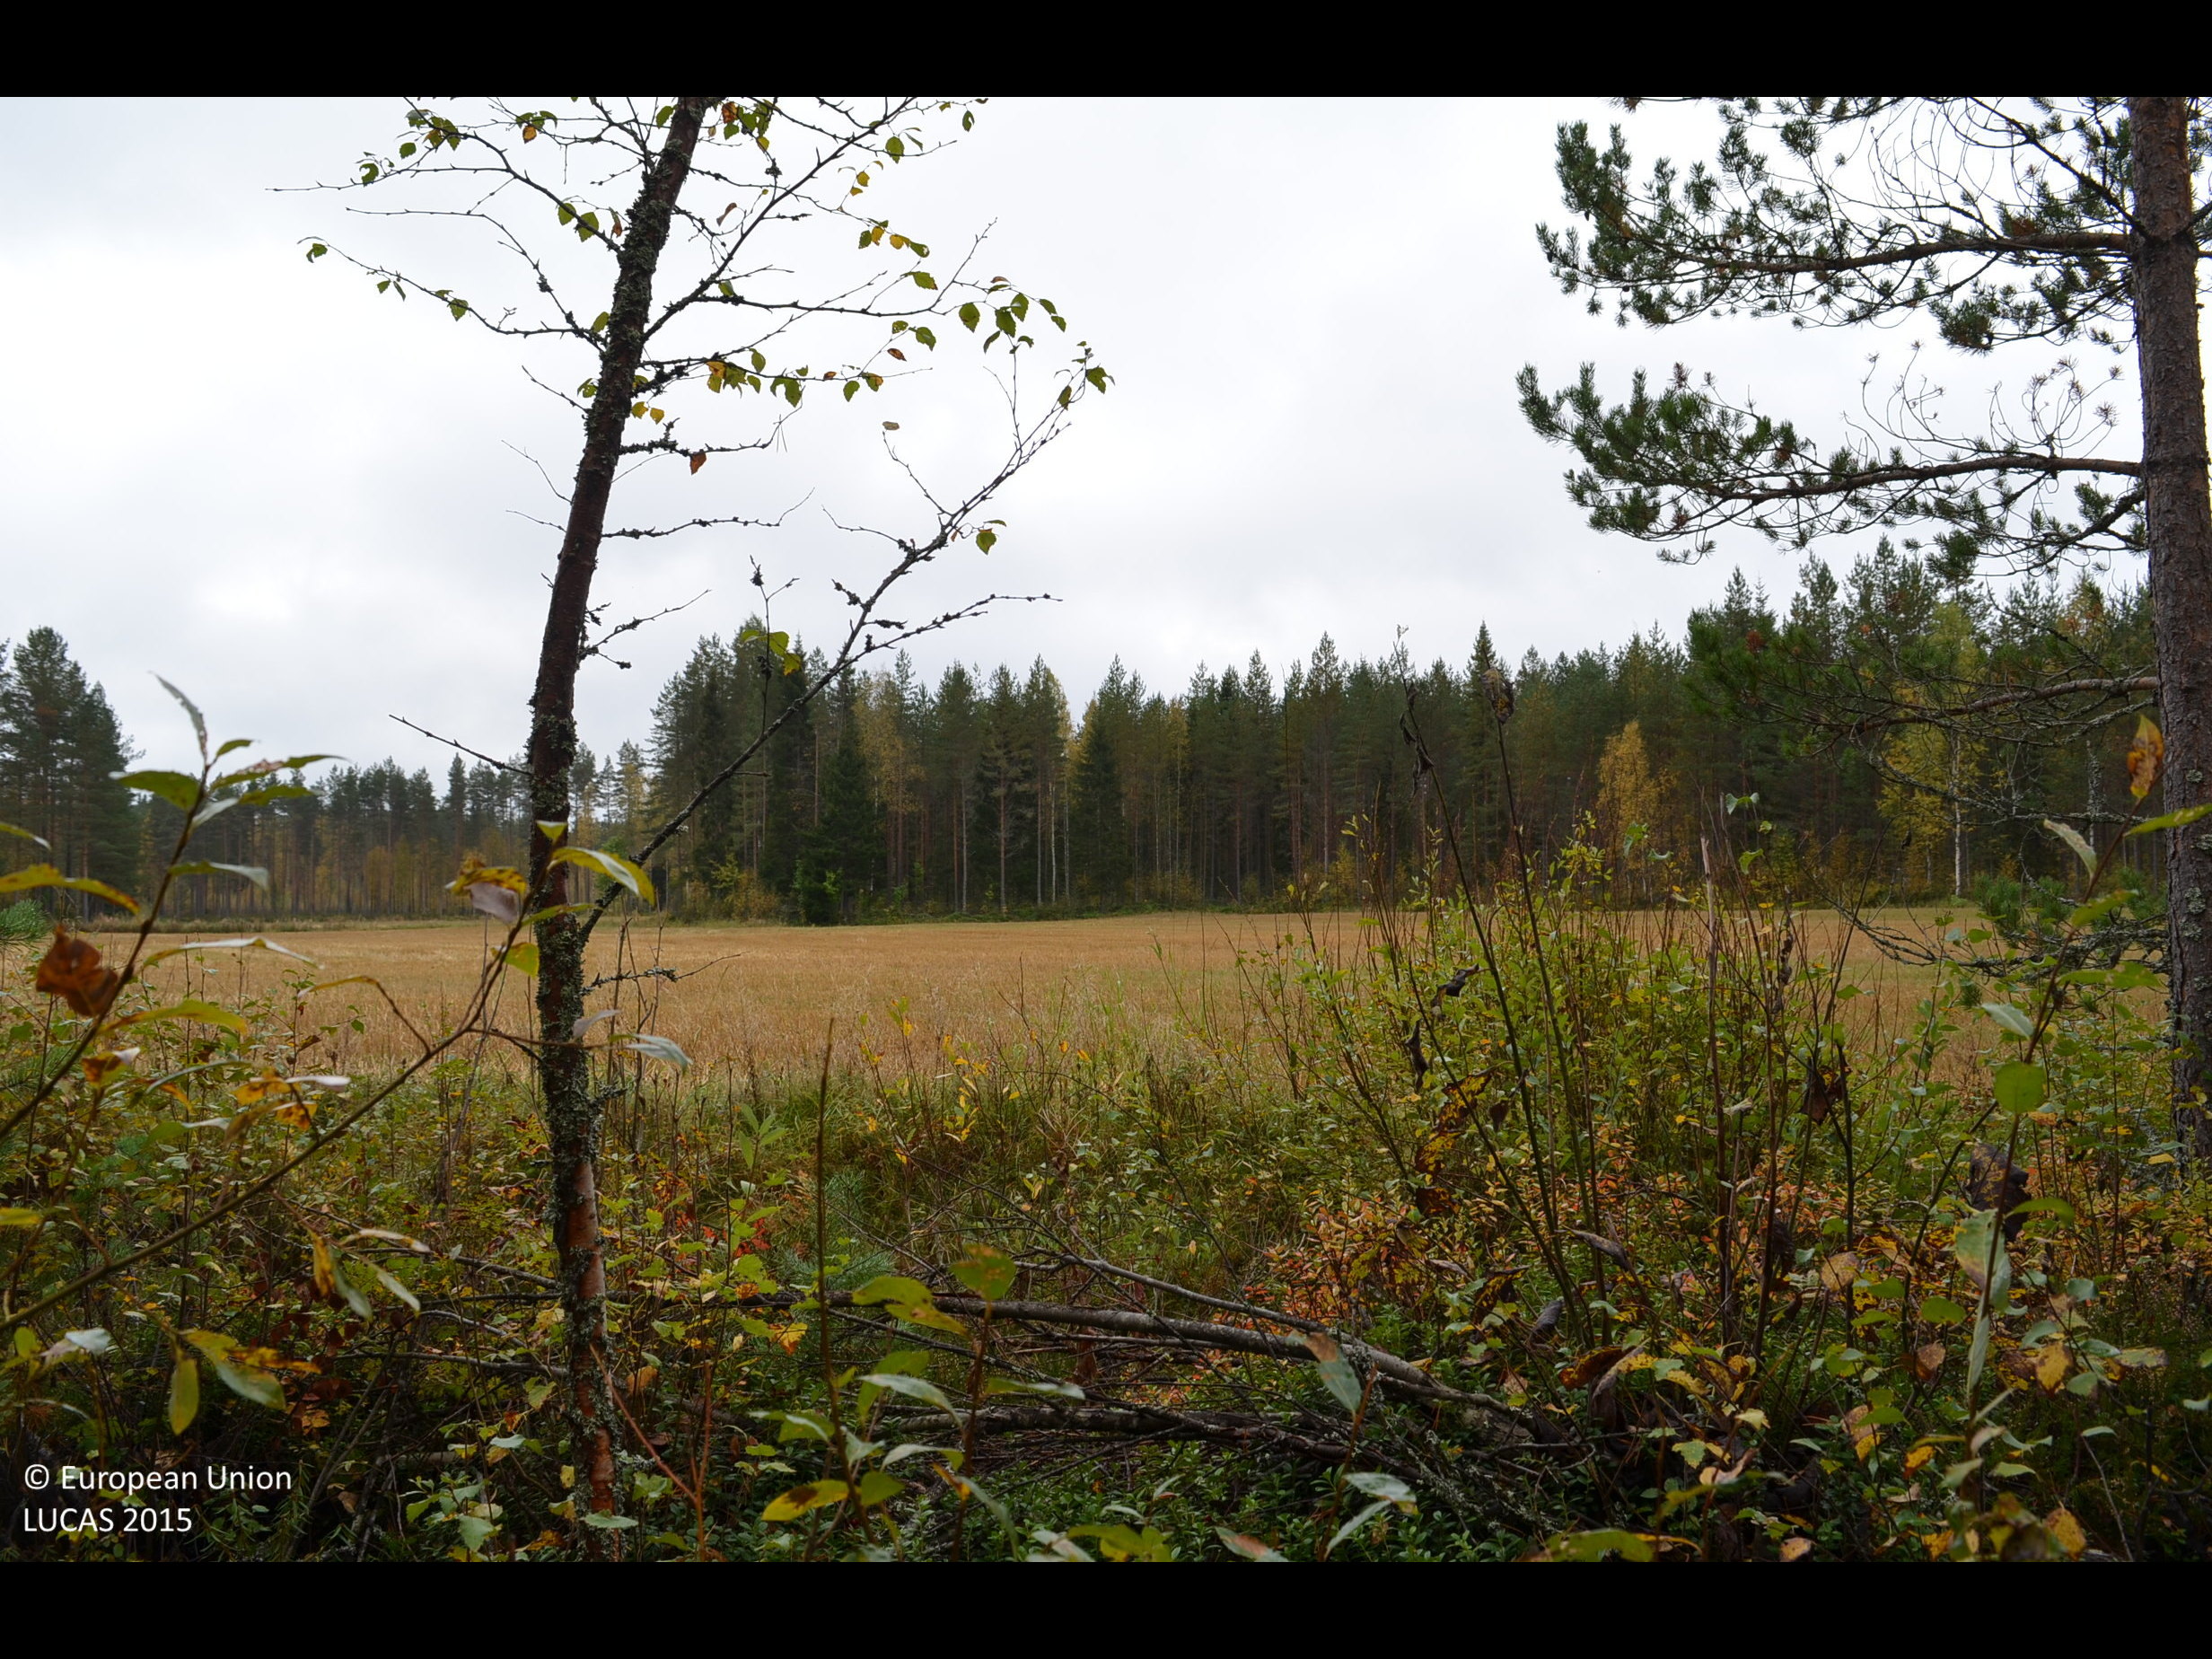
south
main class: Woodland
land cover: Pine dominated coniferous woodland
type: boreal forest
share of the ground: > 75 %
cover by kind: coniferous forest trees 75 %, shrubs 20 %, broadleaved forest trees 5 %
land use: Forestry
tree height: > 5 m
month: September
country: FI
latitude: 62.6564
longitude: 23.7539
